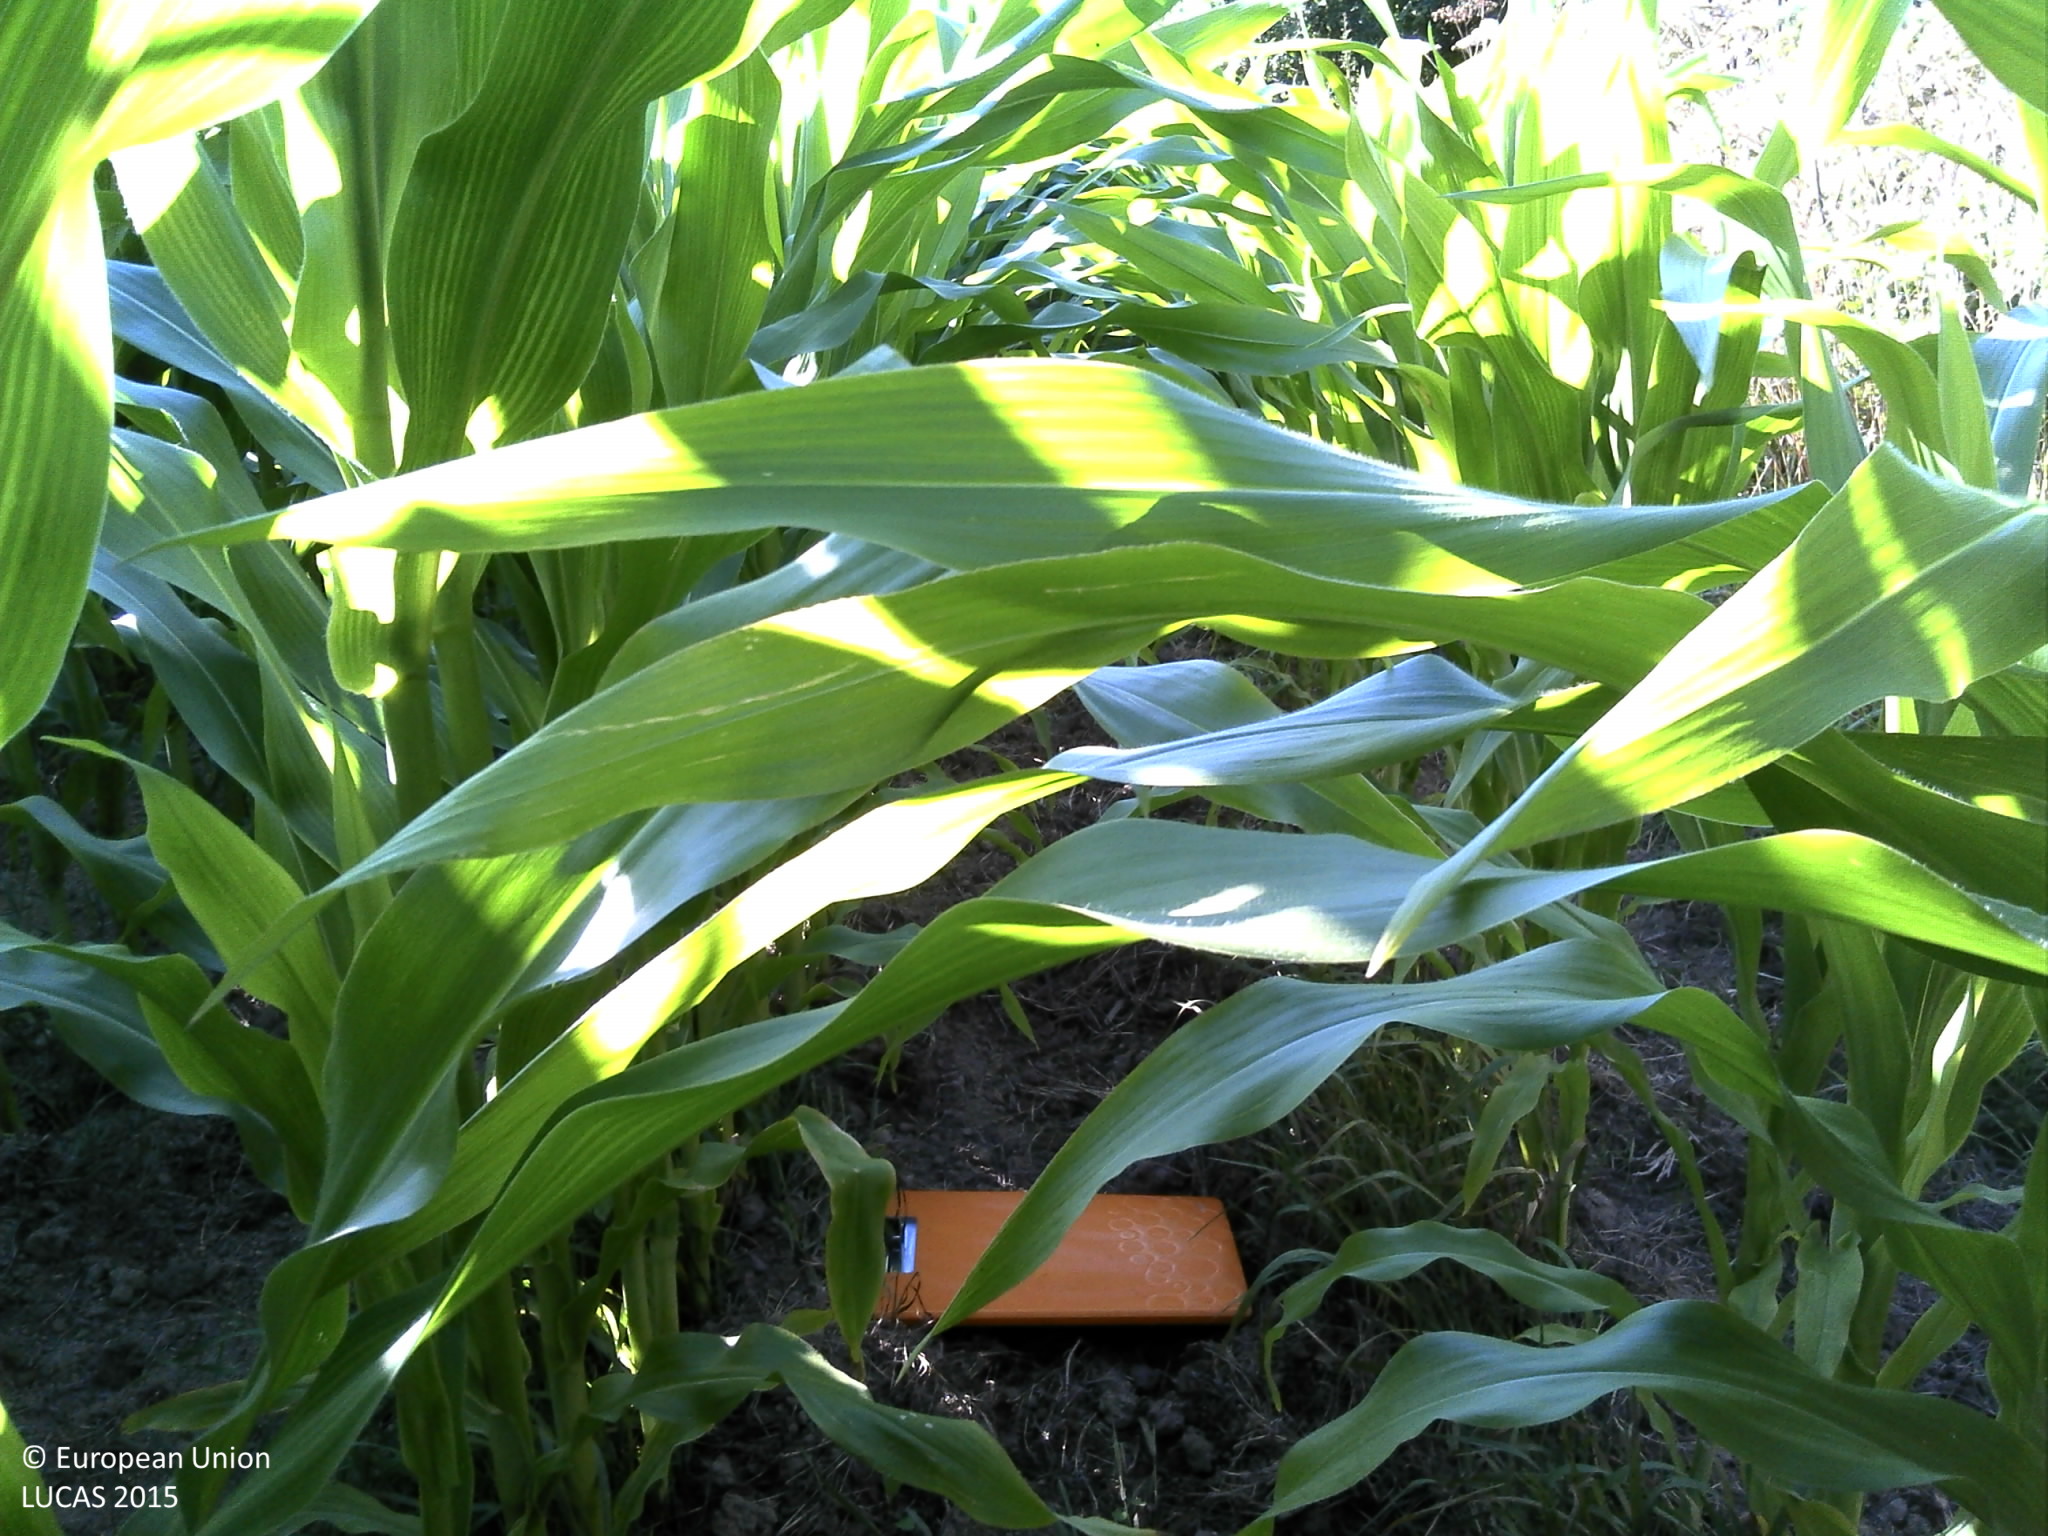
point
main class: Cropland
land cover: Maize
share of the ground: > 75 %
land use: Agriculture (excluding fallow land and kitchen gardens)
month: July
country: FR
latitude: 48.5384
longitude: -4.4964
